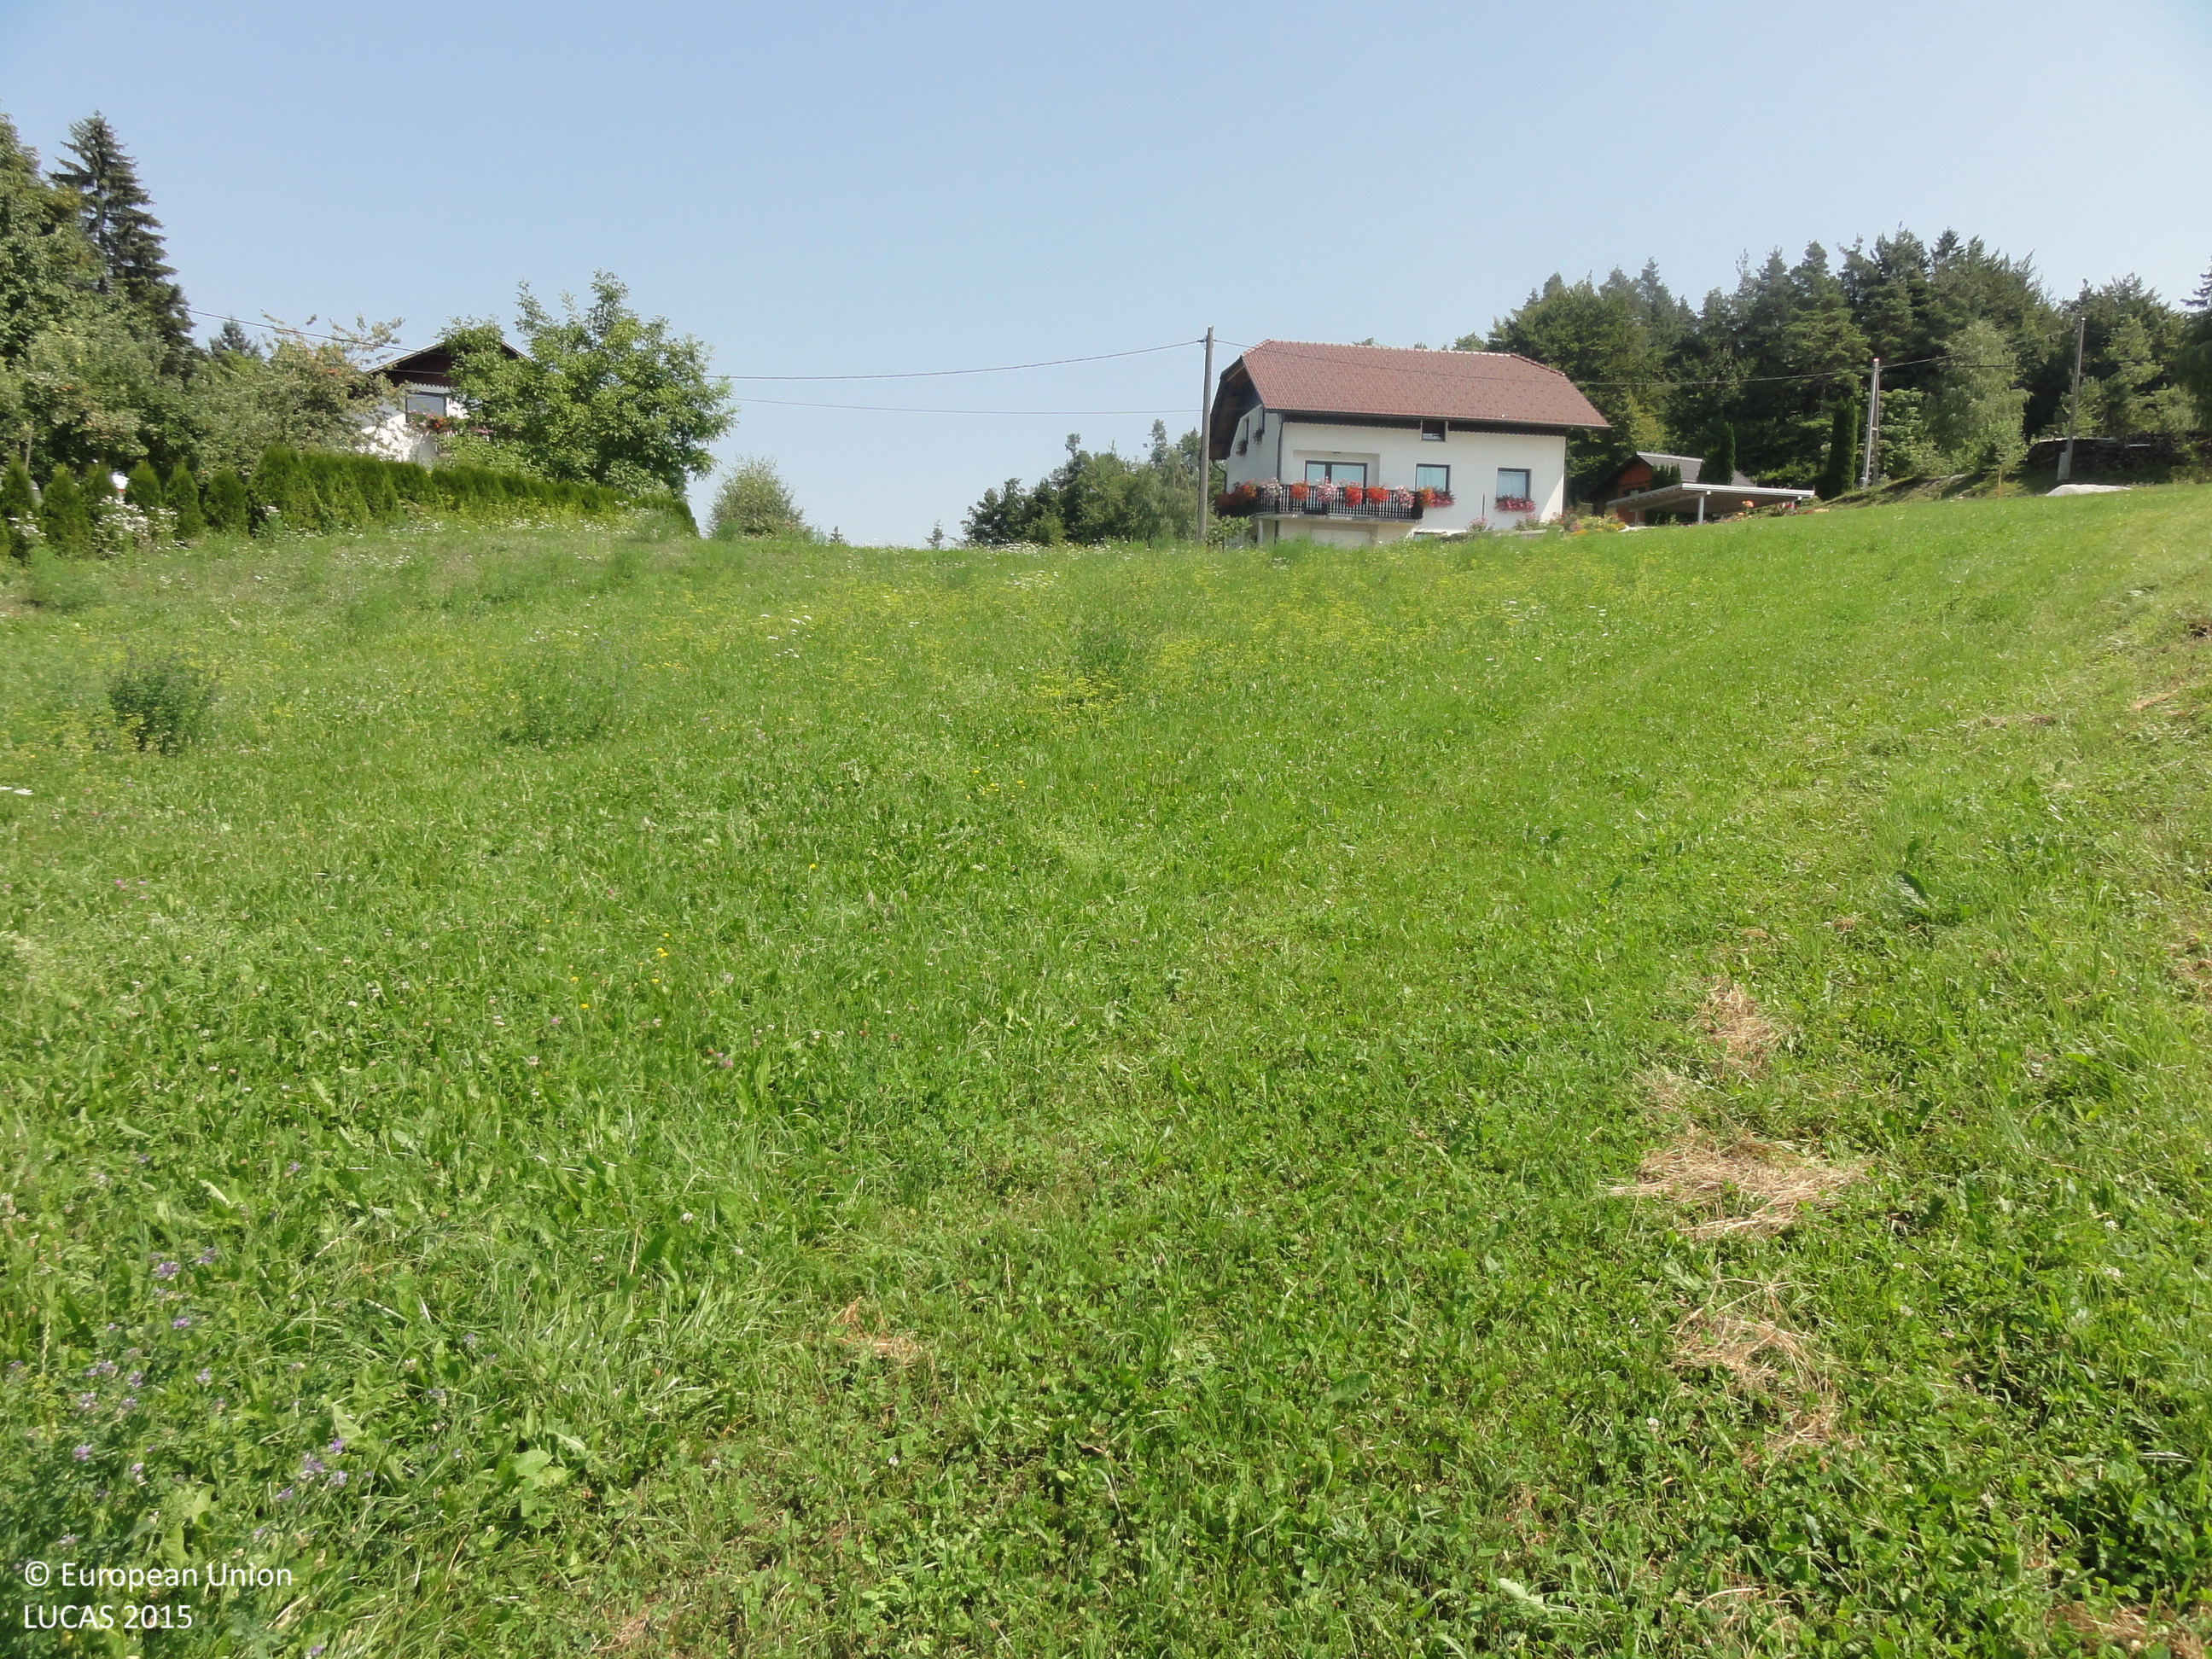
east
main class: Grassland
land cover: Grassland without tree/shrub cover
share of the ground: > 75 %
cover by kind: herbaceous plants 100 %
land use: Agriculture (excluding fallow land and kitchen gardens)
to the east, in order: Grassland without tree/shrub cover; Artificial constructions in urban areas; Grassland without tree/shrub cover; Electric lines; Grassland without tree/shrub cover
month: August
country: SI
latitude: 46.0347
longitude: 15.0230
